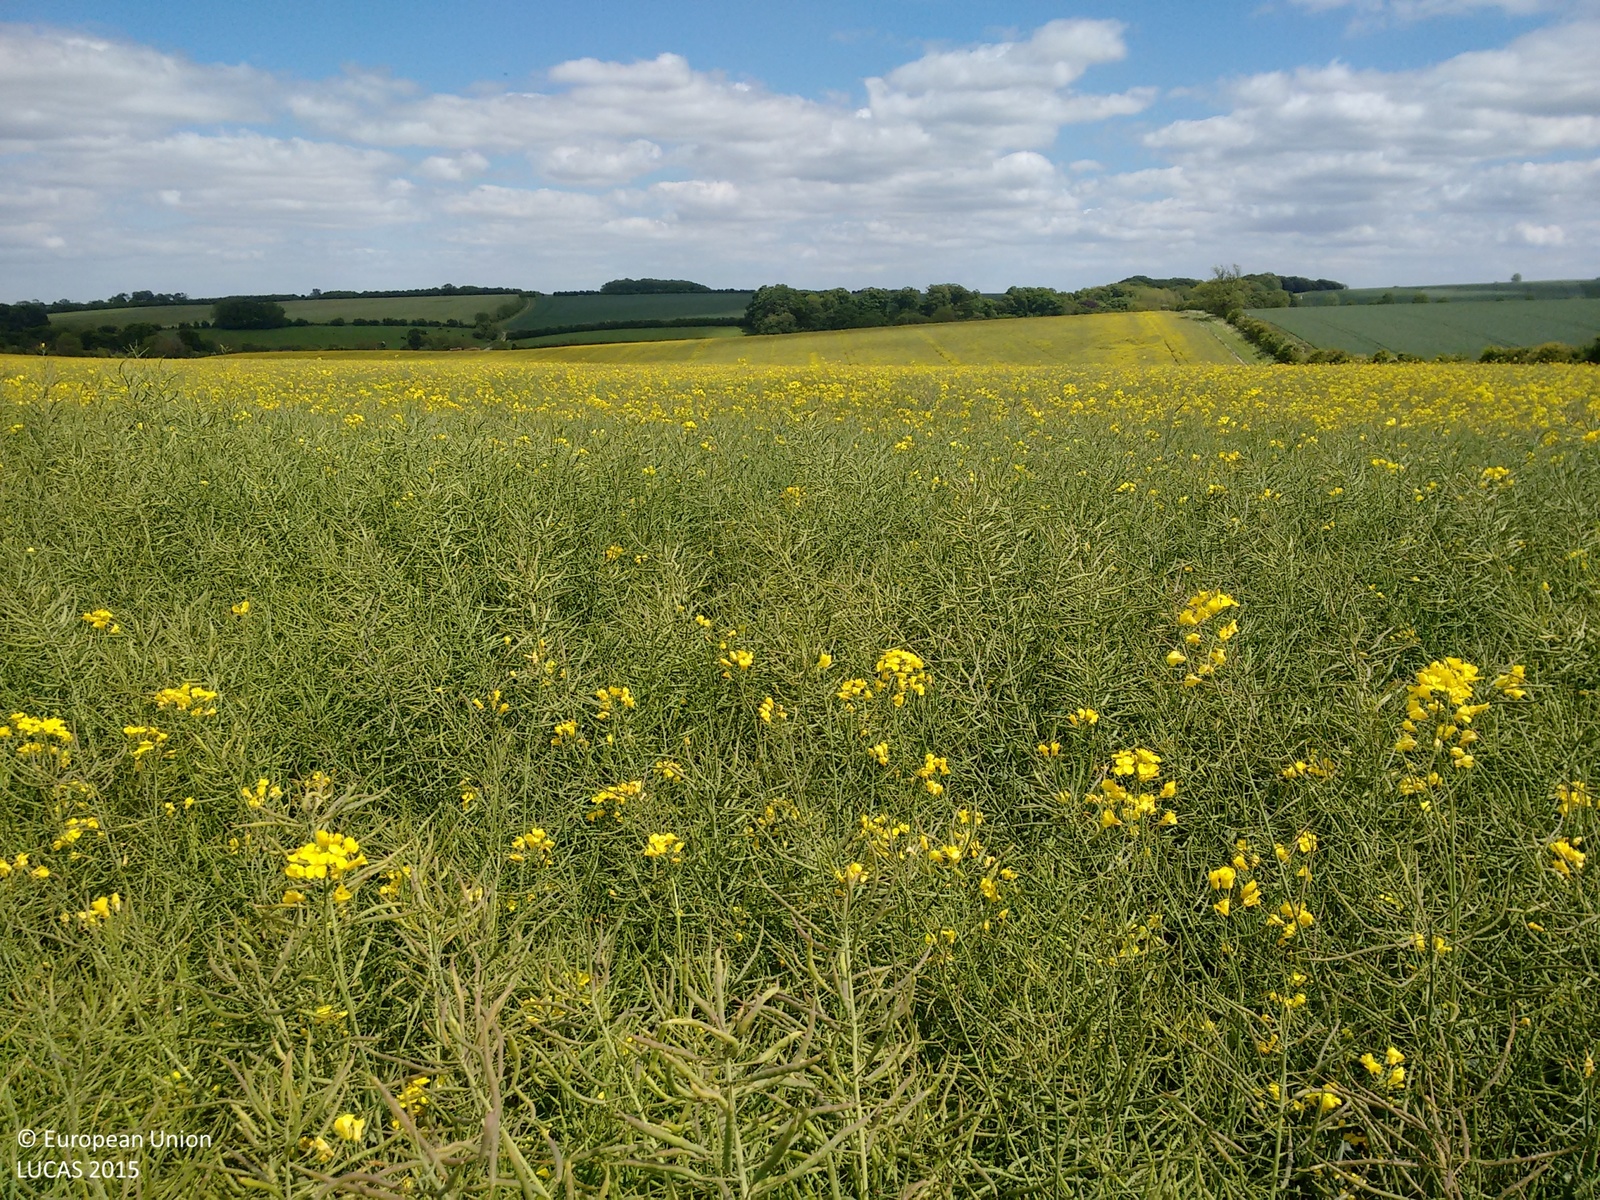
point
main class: Cropland
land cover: Rape and turnip rape
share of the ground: > 75 %
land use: Agriculture (excluding fallow land and kitchen gardens)
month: June
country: GB
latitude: 53.4468
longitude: -0.1362
